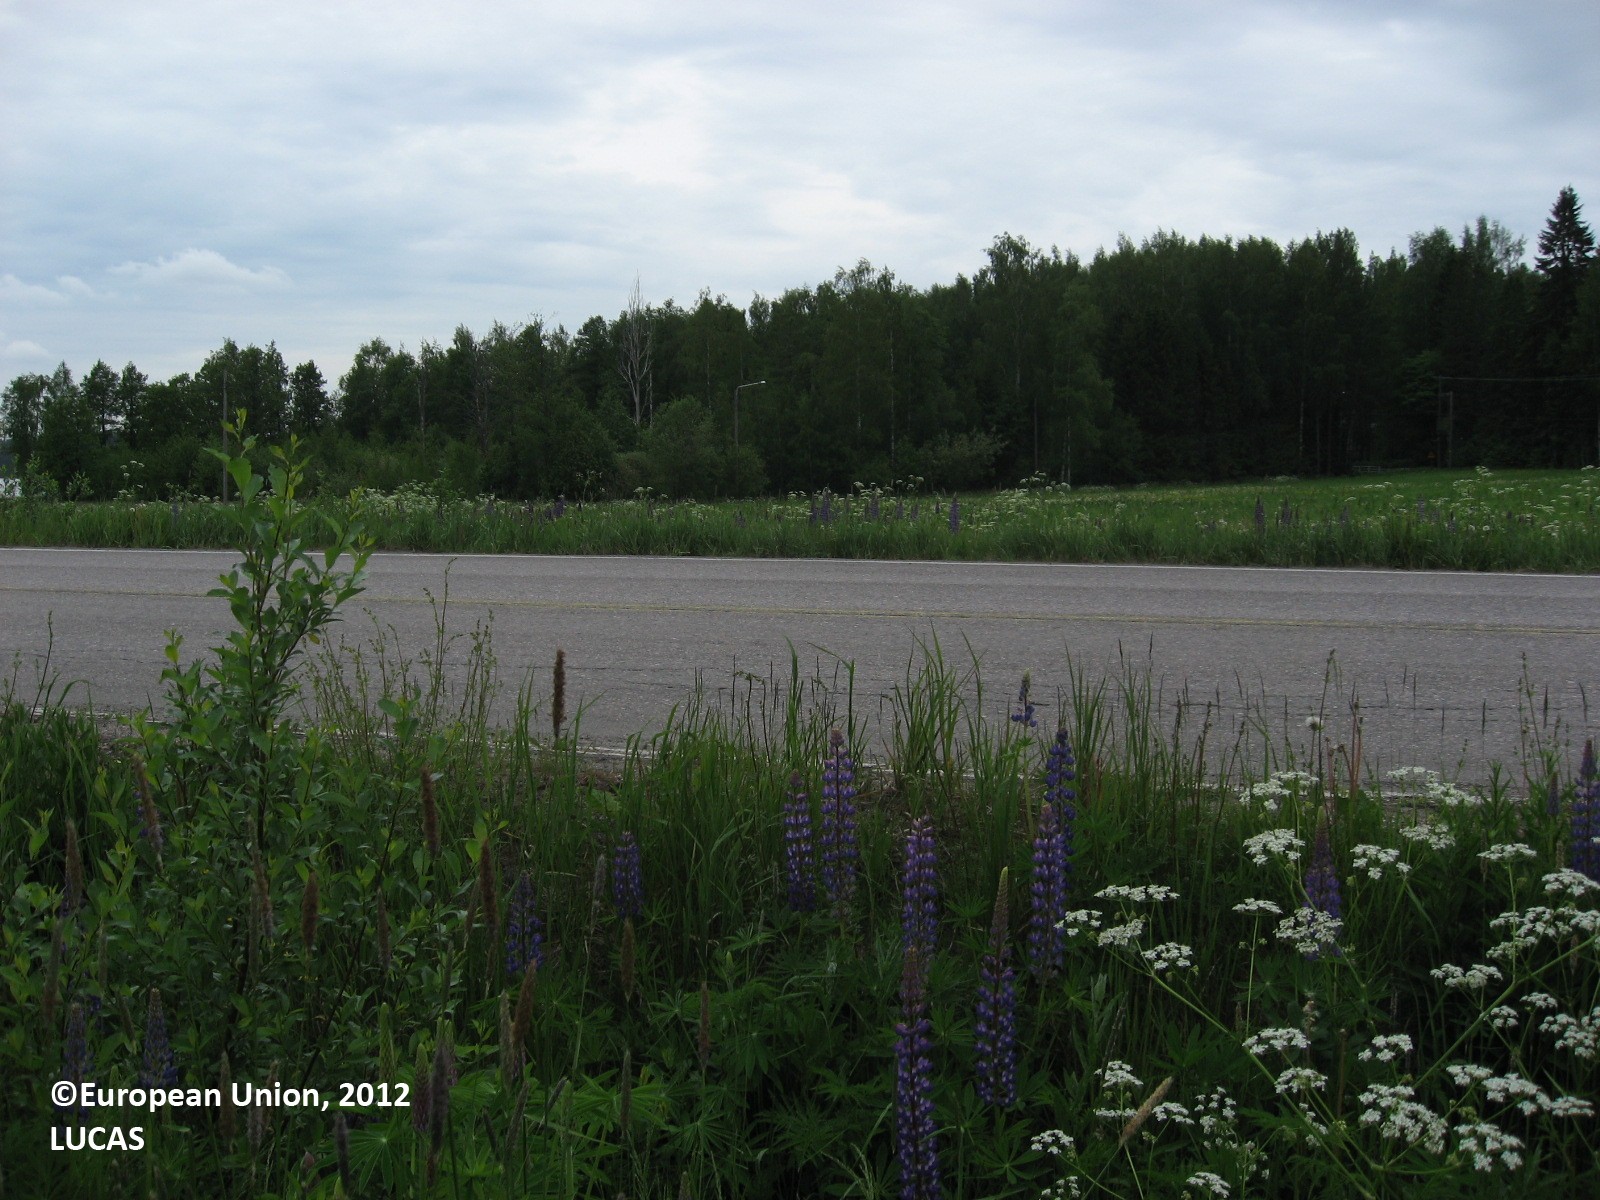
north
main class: Cropland
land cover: Other cereals
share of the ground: < 10 %
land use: Agriculture (excluding fallow land and kitchen gardens)
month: June
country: FI
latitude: 60.4202
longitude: 24.9916
